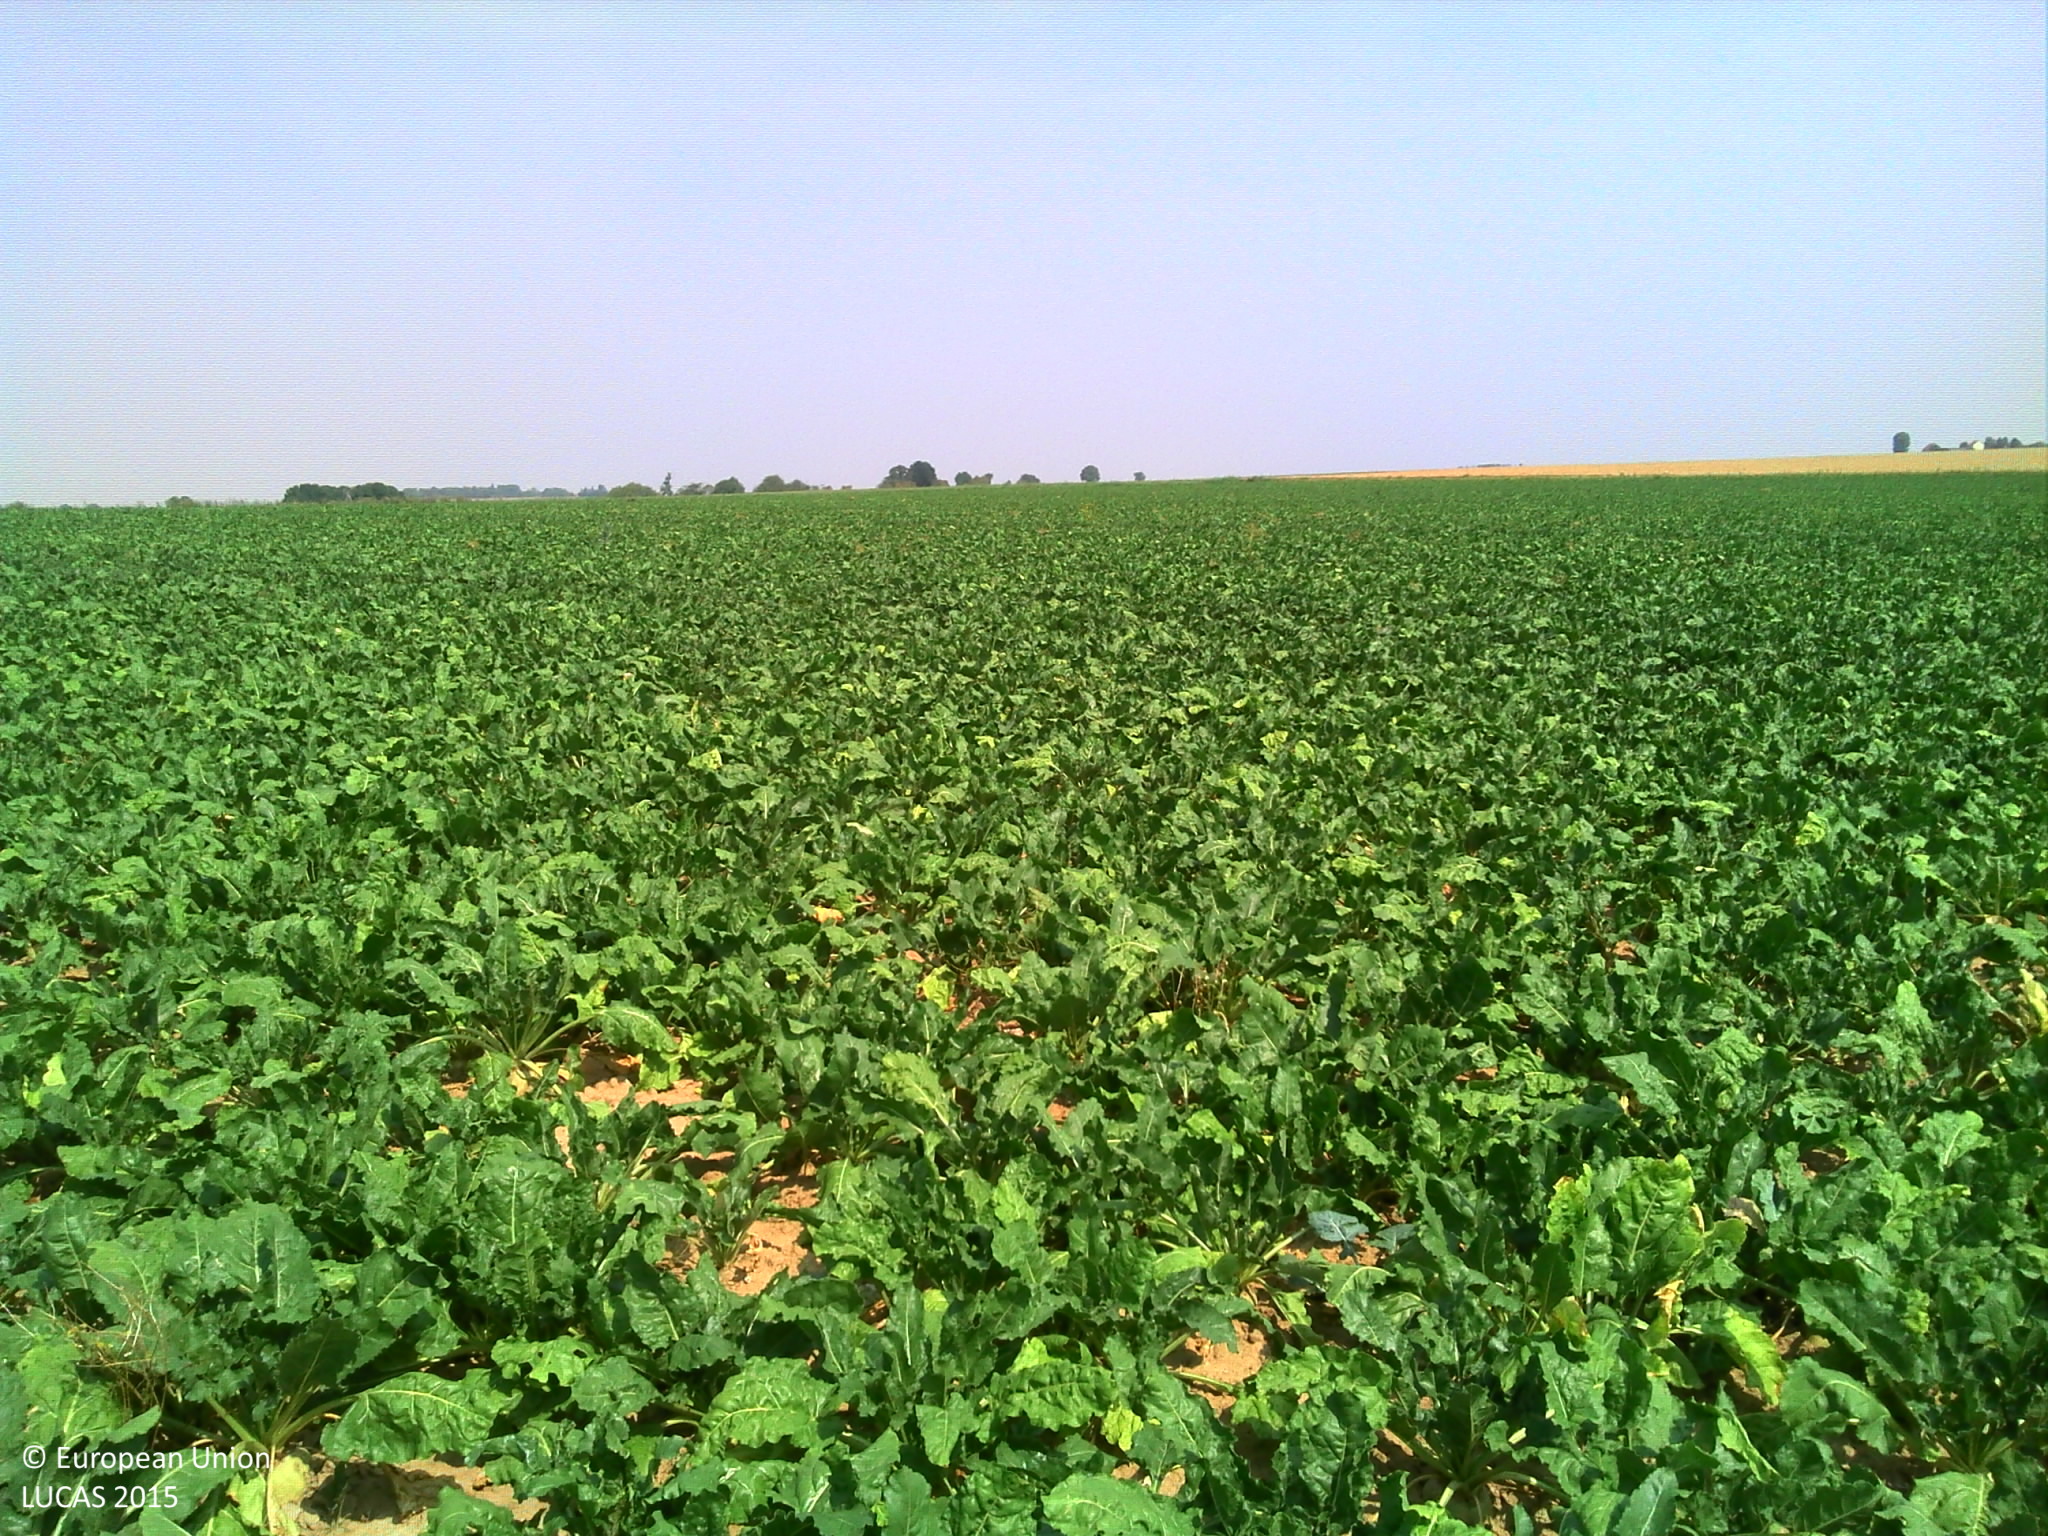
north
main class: Cropland
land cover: Sugar beet
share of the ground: > 75 %
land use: Agriculture (excluding fallow land and kitchen gardens)
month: August
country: FR
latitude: 49.0628
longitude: 2.9424
